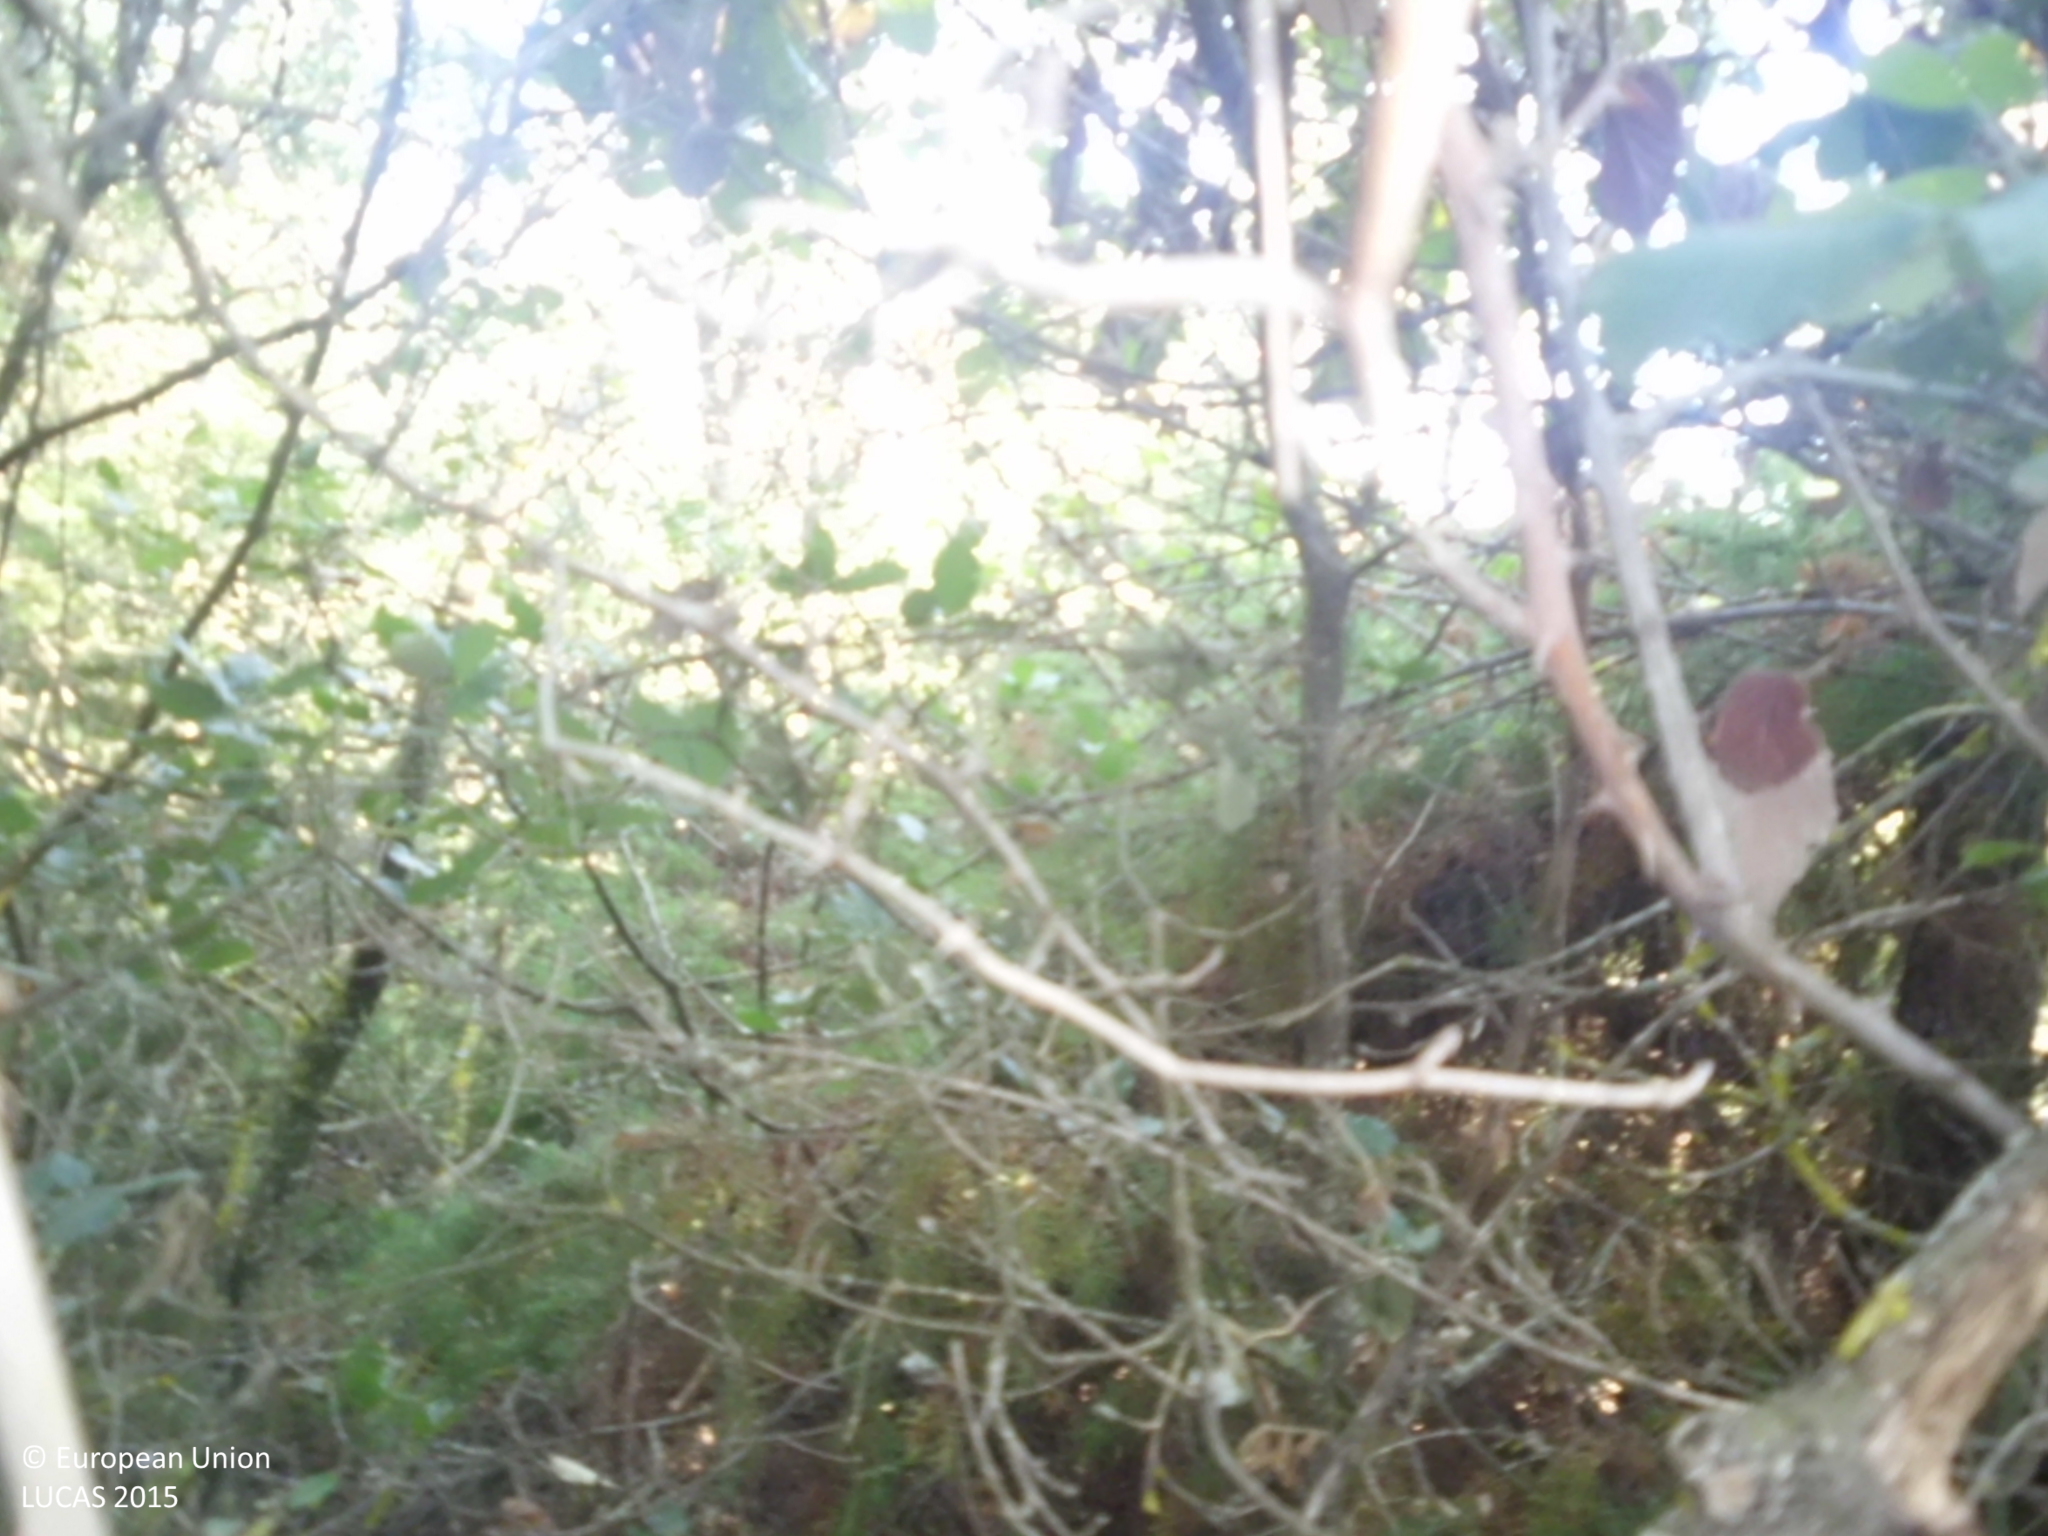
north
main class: Woodland
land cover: Broadleaved woodland
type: broadleaved evergreen forest
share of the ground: > 75 %
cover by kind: broadleaved forest trees 100 %
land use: Forestry
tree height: > 5 m
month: July
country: ES
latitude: 42.2736
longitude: -3.6510
